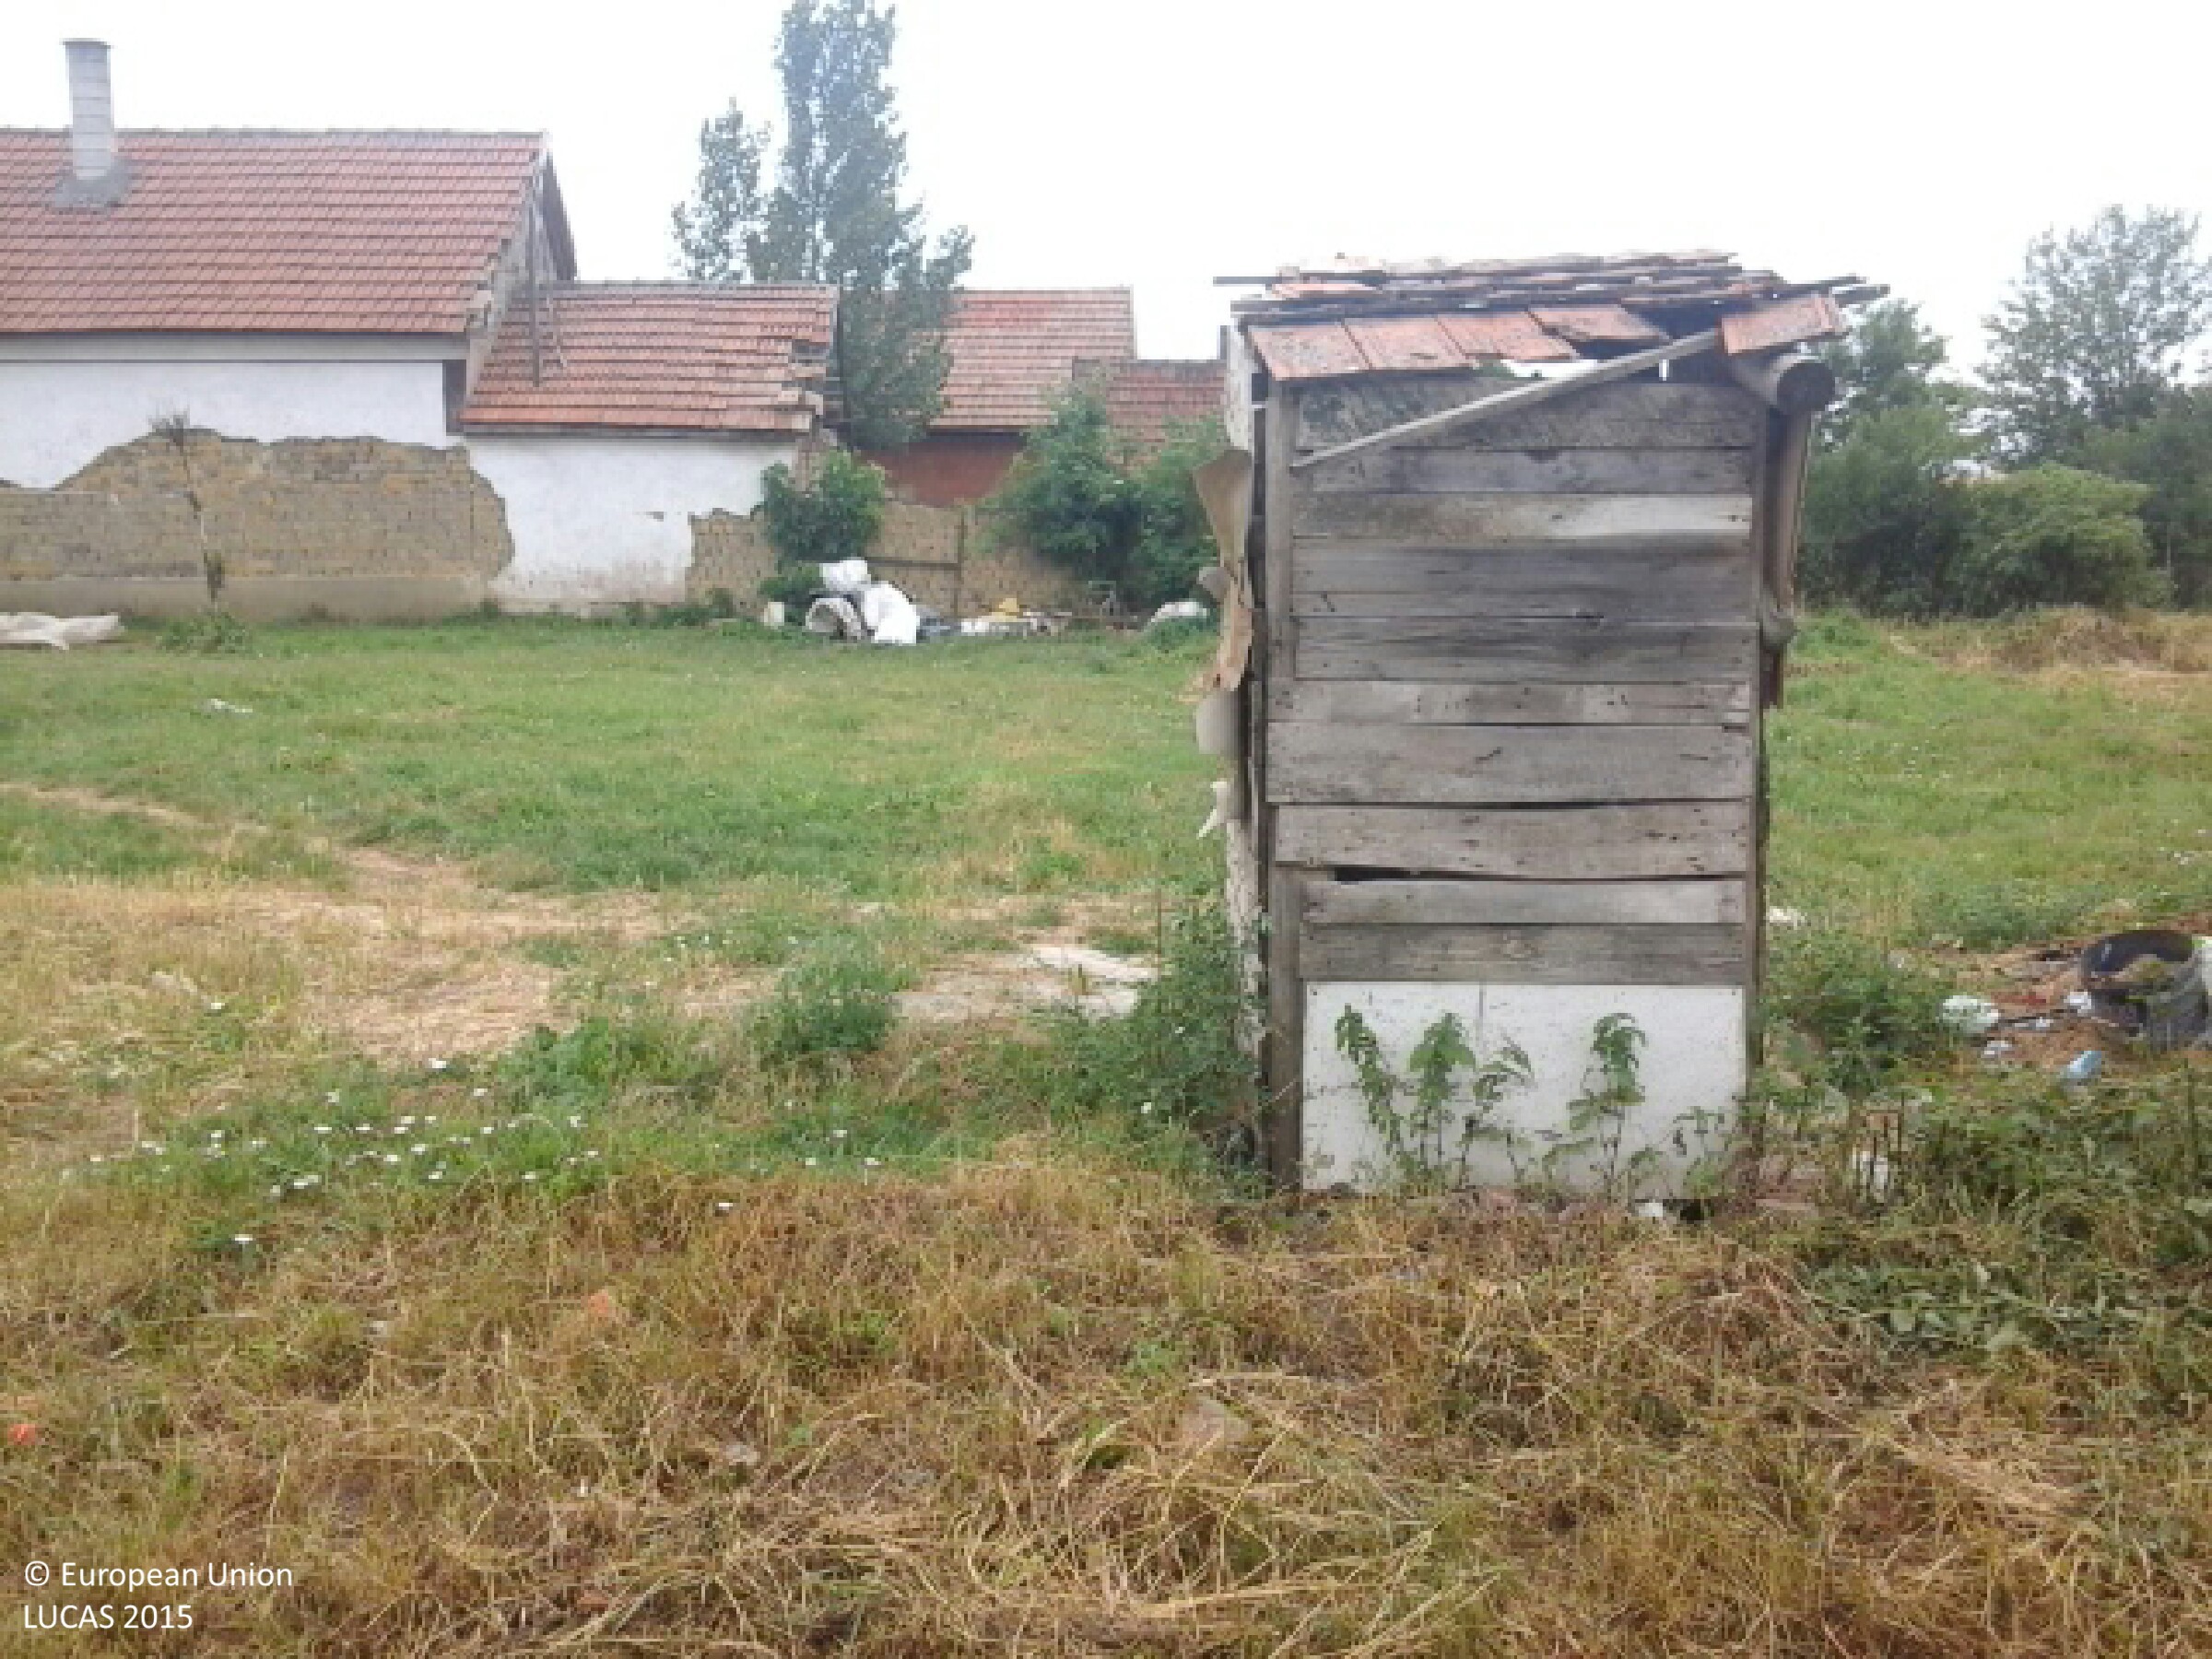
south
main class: Grassland
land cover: Grassland without tree/shrub cover
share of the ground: > 75 %
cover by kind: herbaceous plants 100 %
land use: Residential
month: June
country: HU
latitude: 48.0240
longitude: 21.4555
